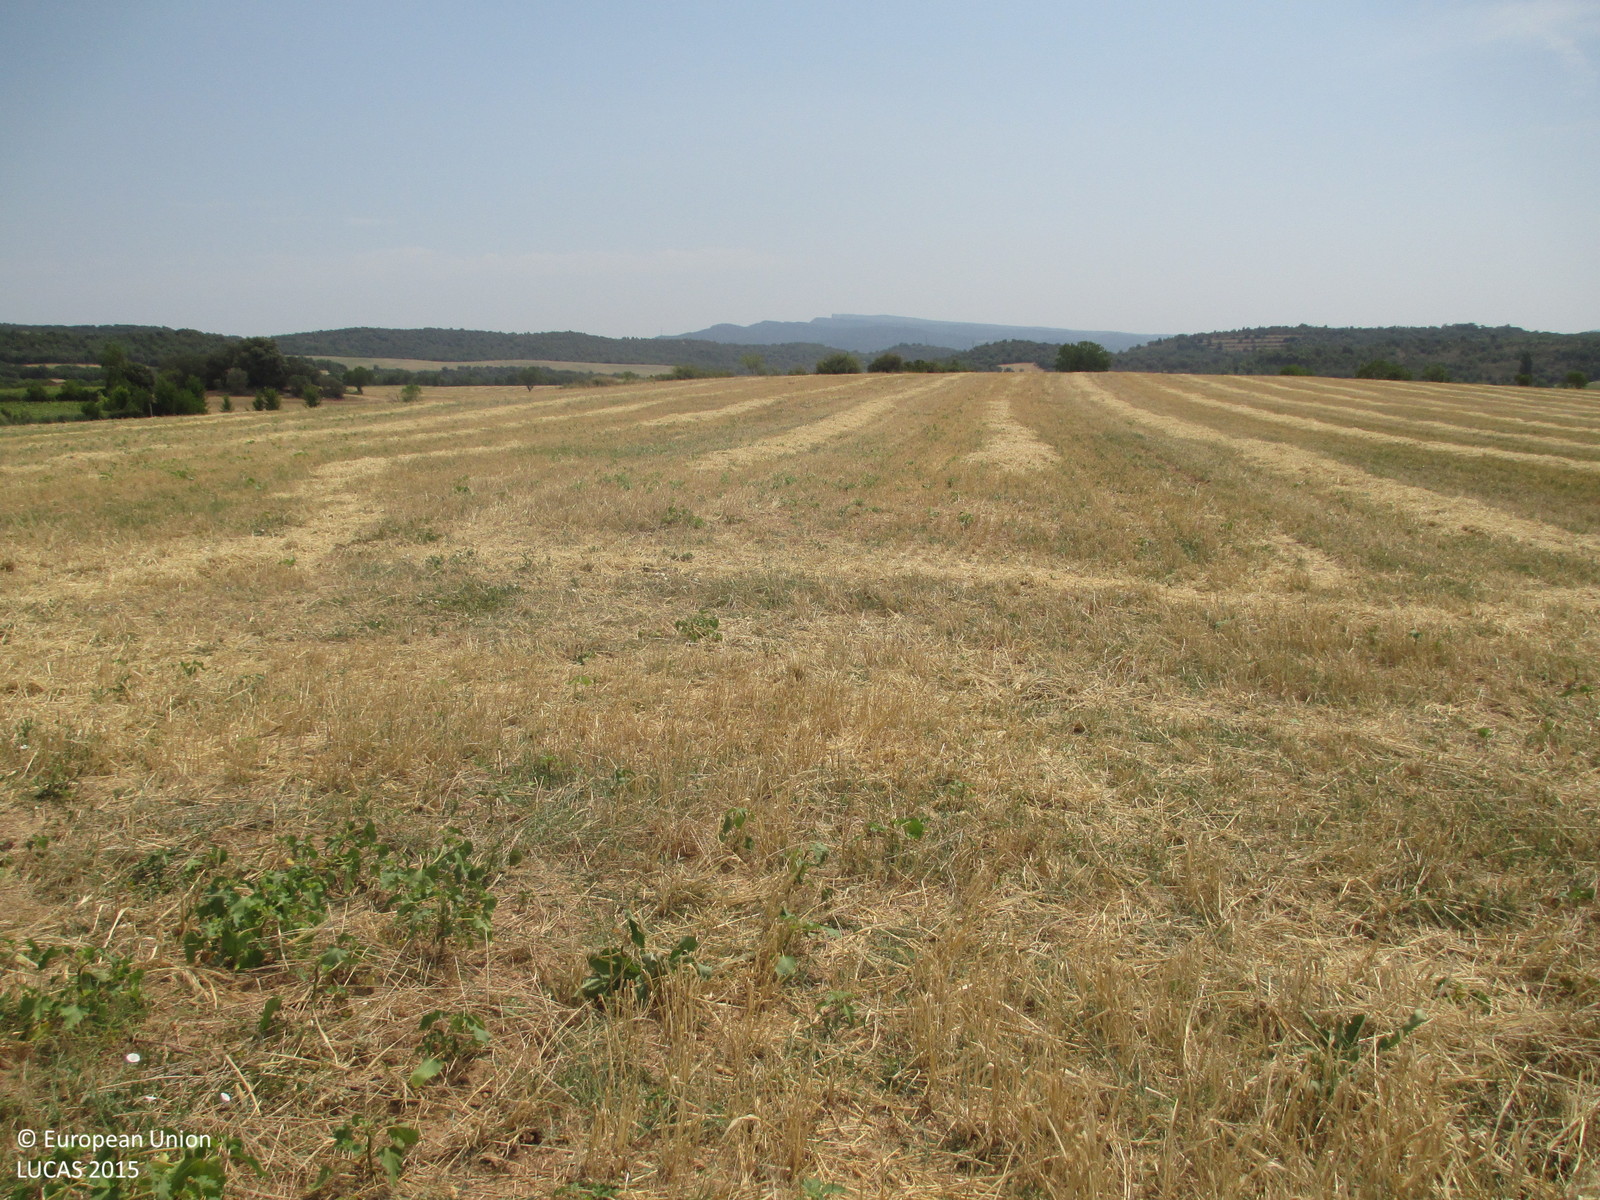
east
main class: Cropland
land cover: Barley
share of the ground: < 10 %
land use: Agriculture (excluding fallow land and kitchen gardens)
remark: Harvested field
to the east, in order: Barley; Shruby margins; Single bushes/trees; Barley; Shruby margins; Single bushes/trees; Barley
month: July
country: ES
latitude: 42.1679
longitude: 0.2858
